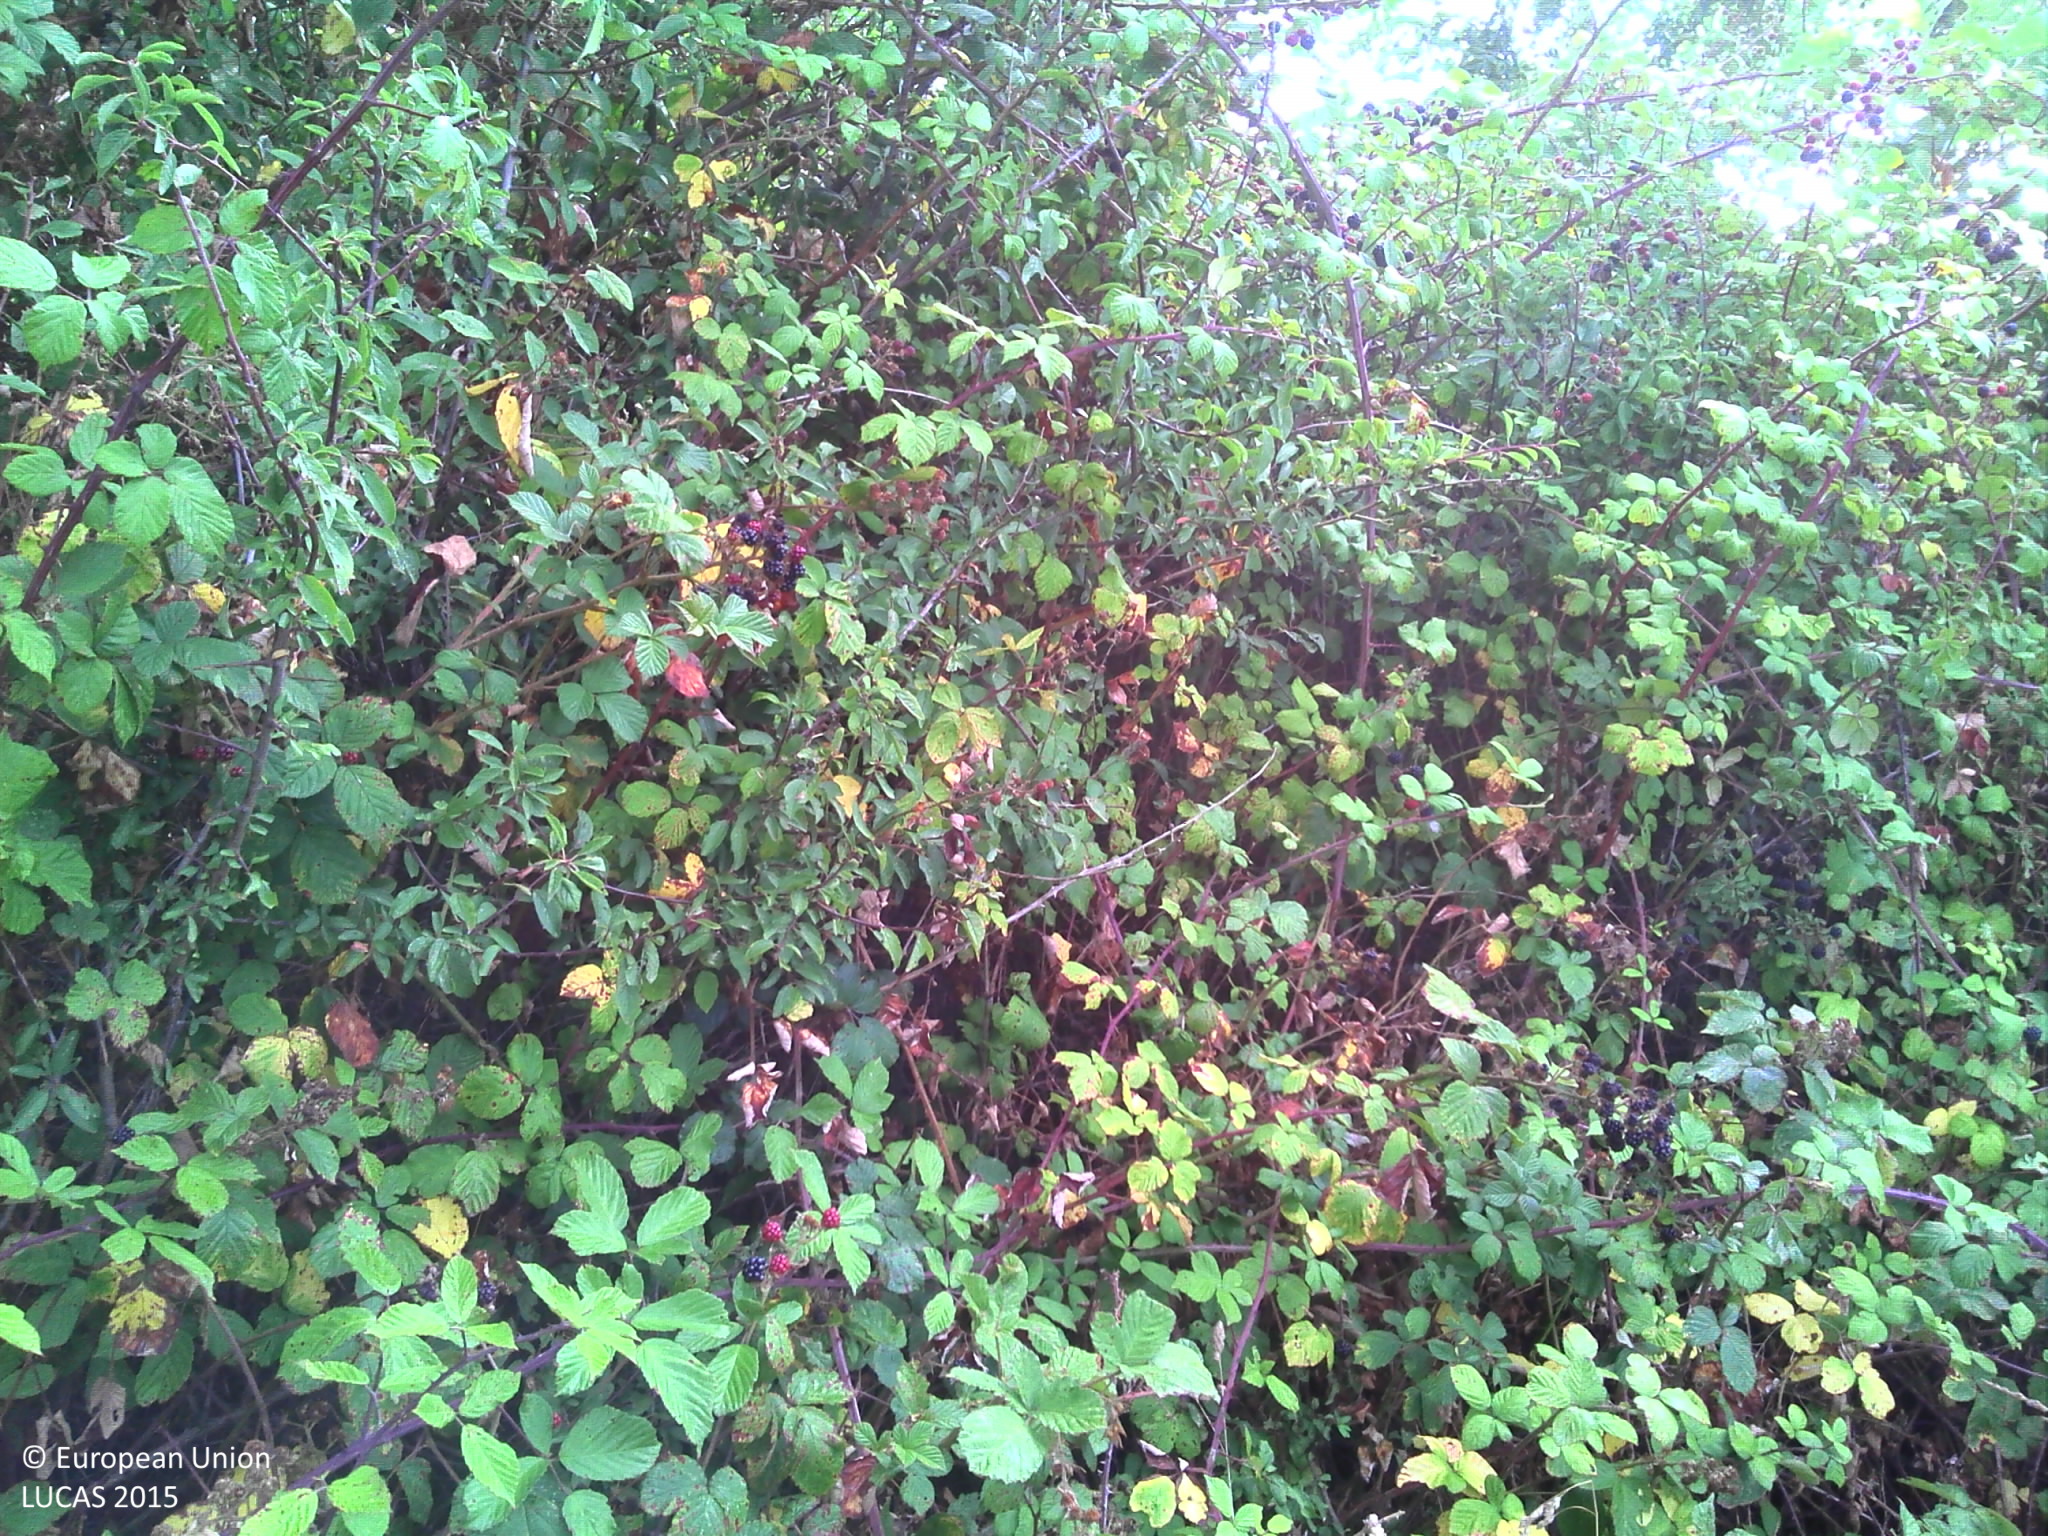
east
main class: Grassland
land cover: Grassland without tree/shrub cover
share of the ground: > 75 %
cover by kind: herbaceous plants 100 %
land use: Agriculture (excluding fallow land and kitchen gardens)
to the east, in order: Grassland without tree/shrub cover; Broadleaved woodland; Fences; Ditches and canals; Grass margins; Paved roads, cycling and walking lanes; Grass margins; Ditches and canals; Abandoned hedges; Fences; Grassland without tree/shrub cover; Fences; Broadleaved woodland; Artificial constructions in urban areas
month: August
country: FR
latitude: 47.4054
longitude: -1.8004
